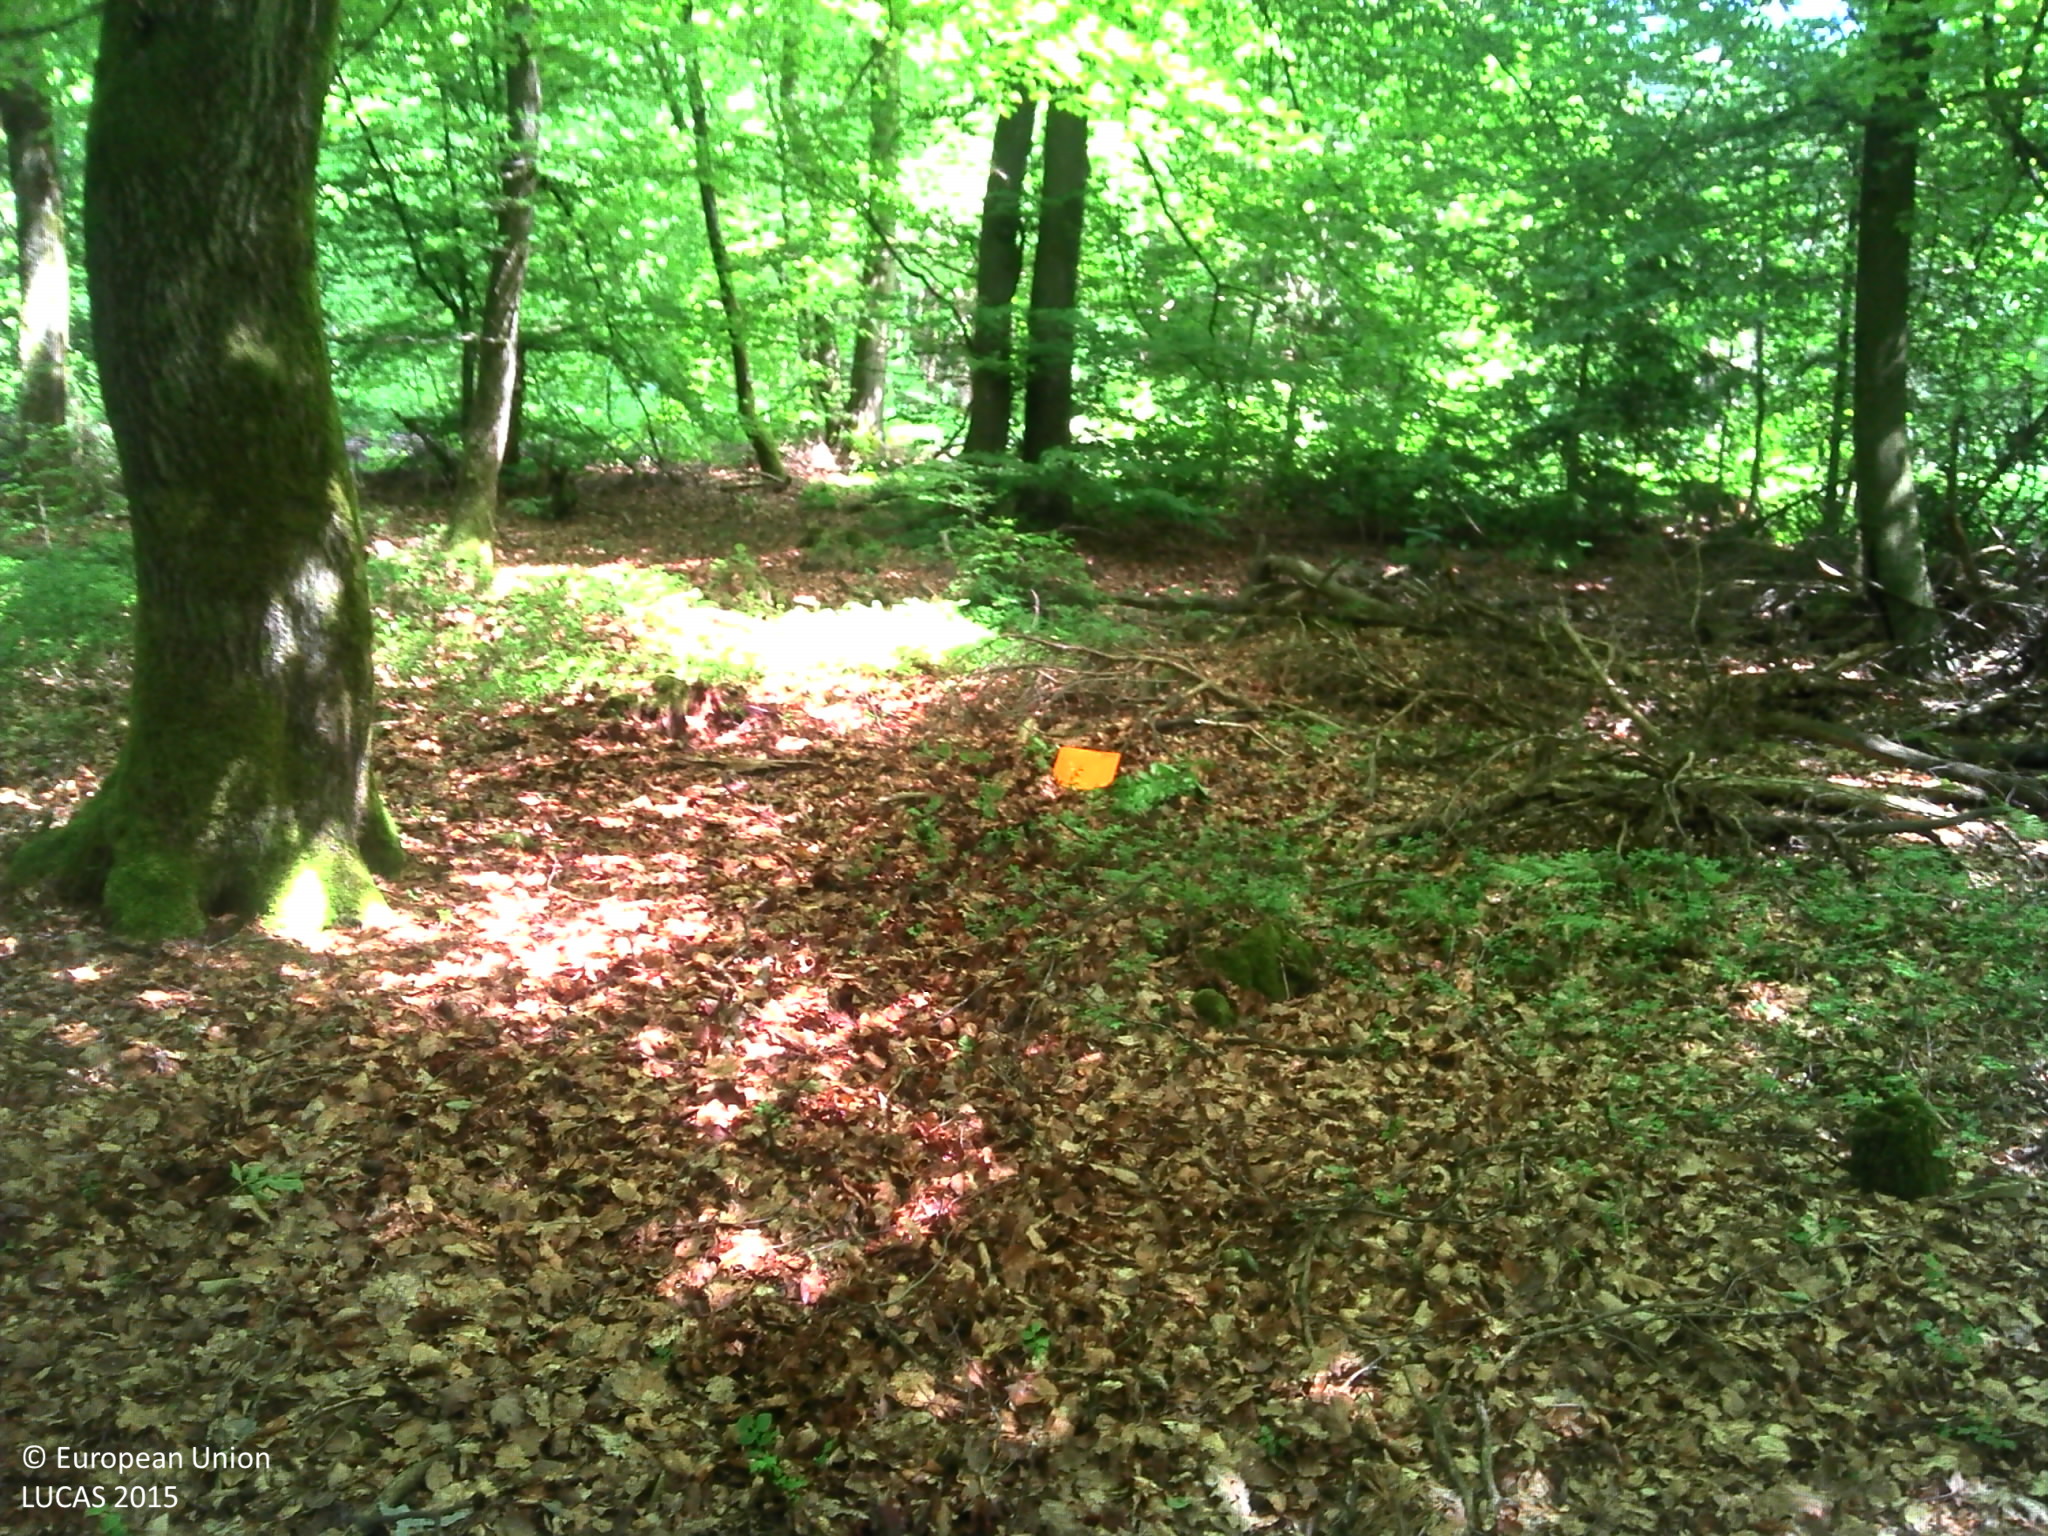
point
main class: Woodland
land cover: Broadleaved woodland
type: acidophilous oak and oak-birch forest
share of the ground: > 75 %
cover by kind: broadleaved forest trees 90 %, coniferous forest trees 5 %, herbaceous plants 5 %
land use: Forestry
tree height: > 5 m
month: May
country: LU
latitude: 49.8424
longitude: 5.9526
